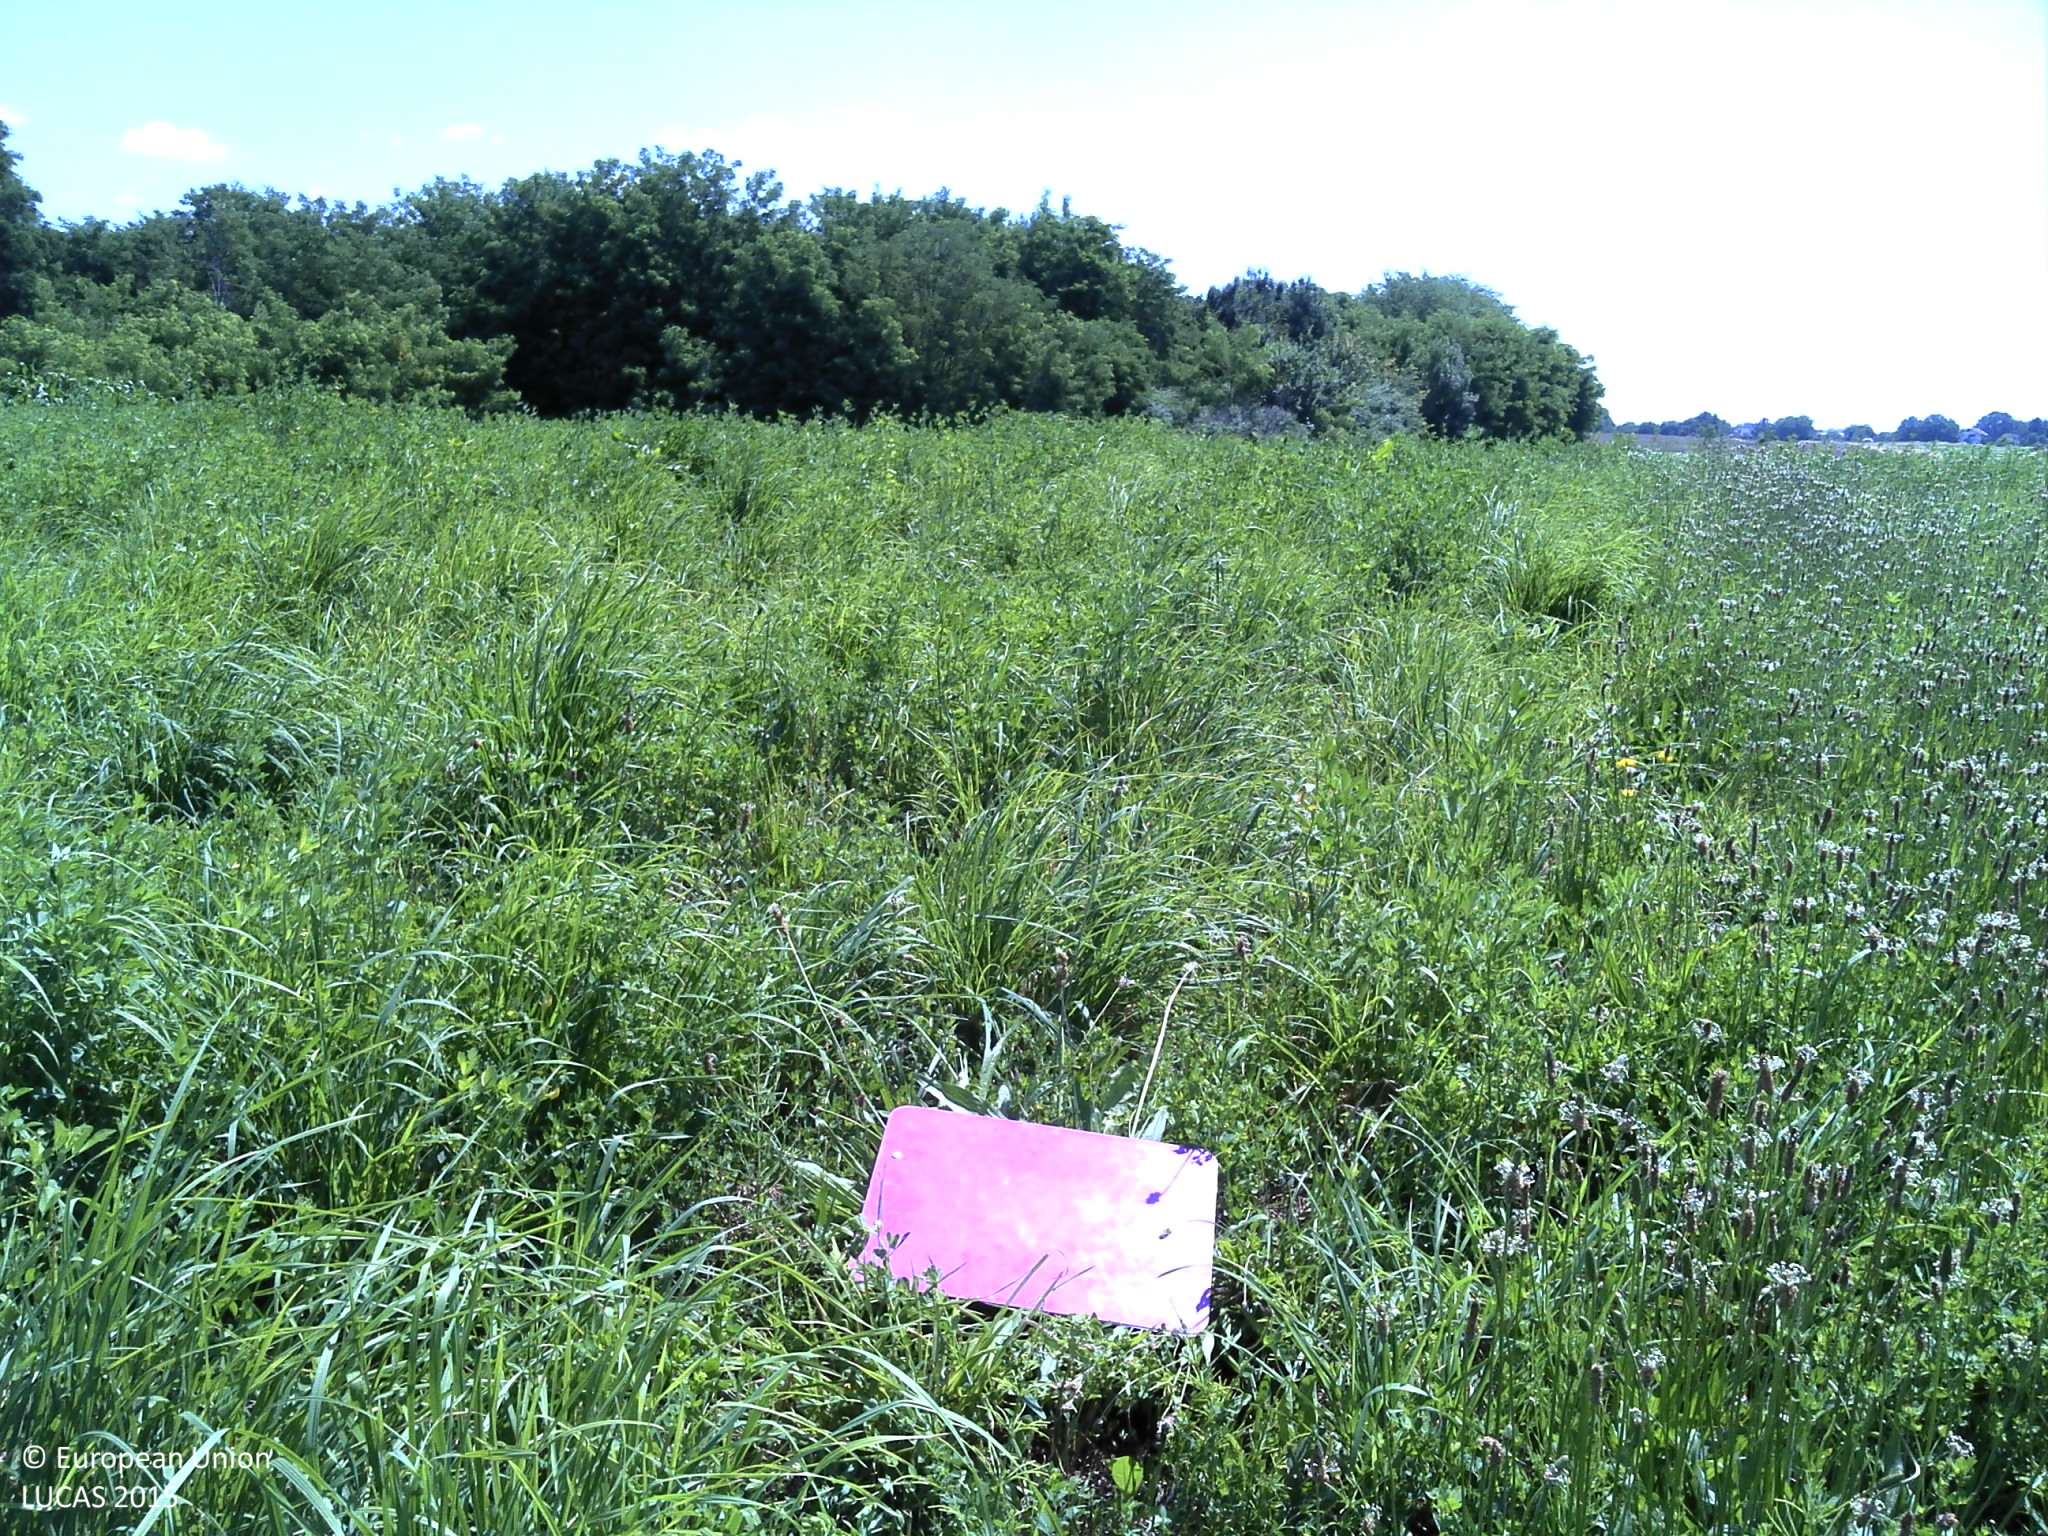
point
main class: Grassland
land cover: Spontaneously vegetated surfaces
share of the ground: > 75 %
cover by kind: herbaceous plants 100 %
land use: Semi-natural and natural areas not in use
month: June
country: HR
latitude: 45.9448
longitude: 17.2128
